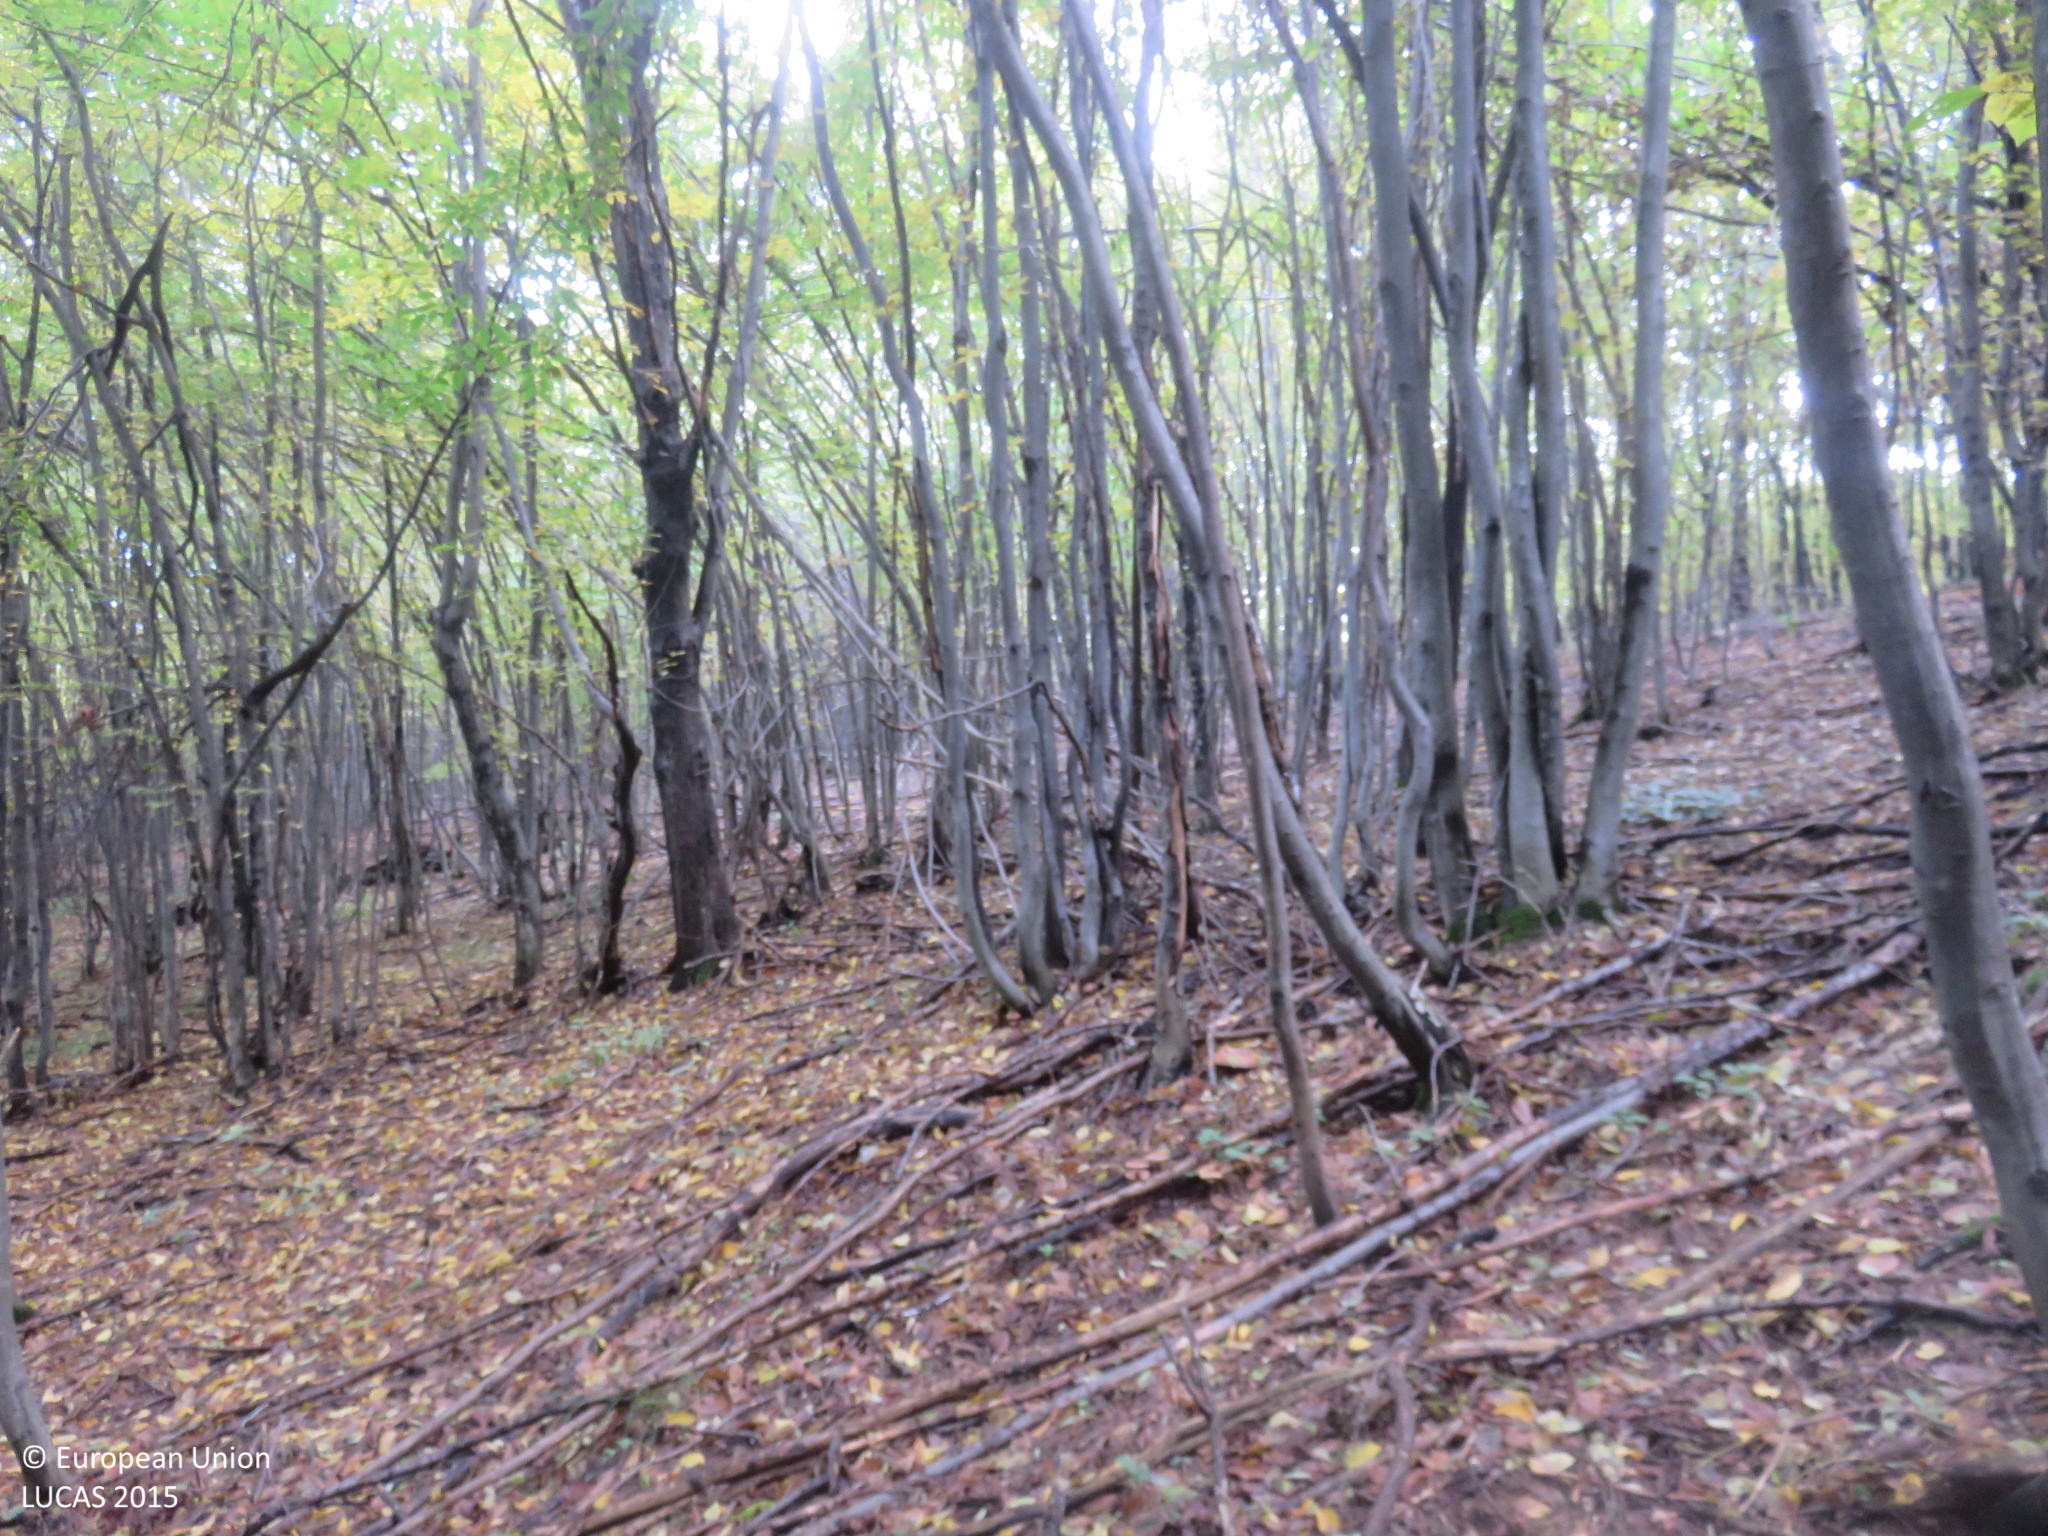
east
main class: Woodland
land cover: Broadleaved woodland
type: beech forest
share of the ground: > 75 %
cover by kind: broadleaved forest trees 95 %, unconsolidated bare surface 5 %
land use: Forestry
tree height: > 5 m
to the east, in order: Broadleaved woodland; Tracks; Broadleaved woodland; Grassland without tree/shrub cover
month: October
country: BG
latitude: 42.9648
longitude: 25.2104
